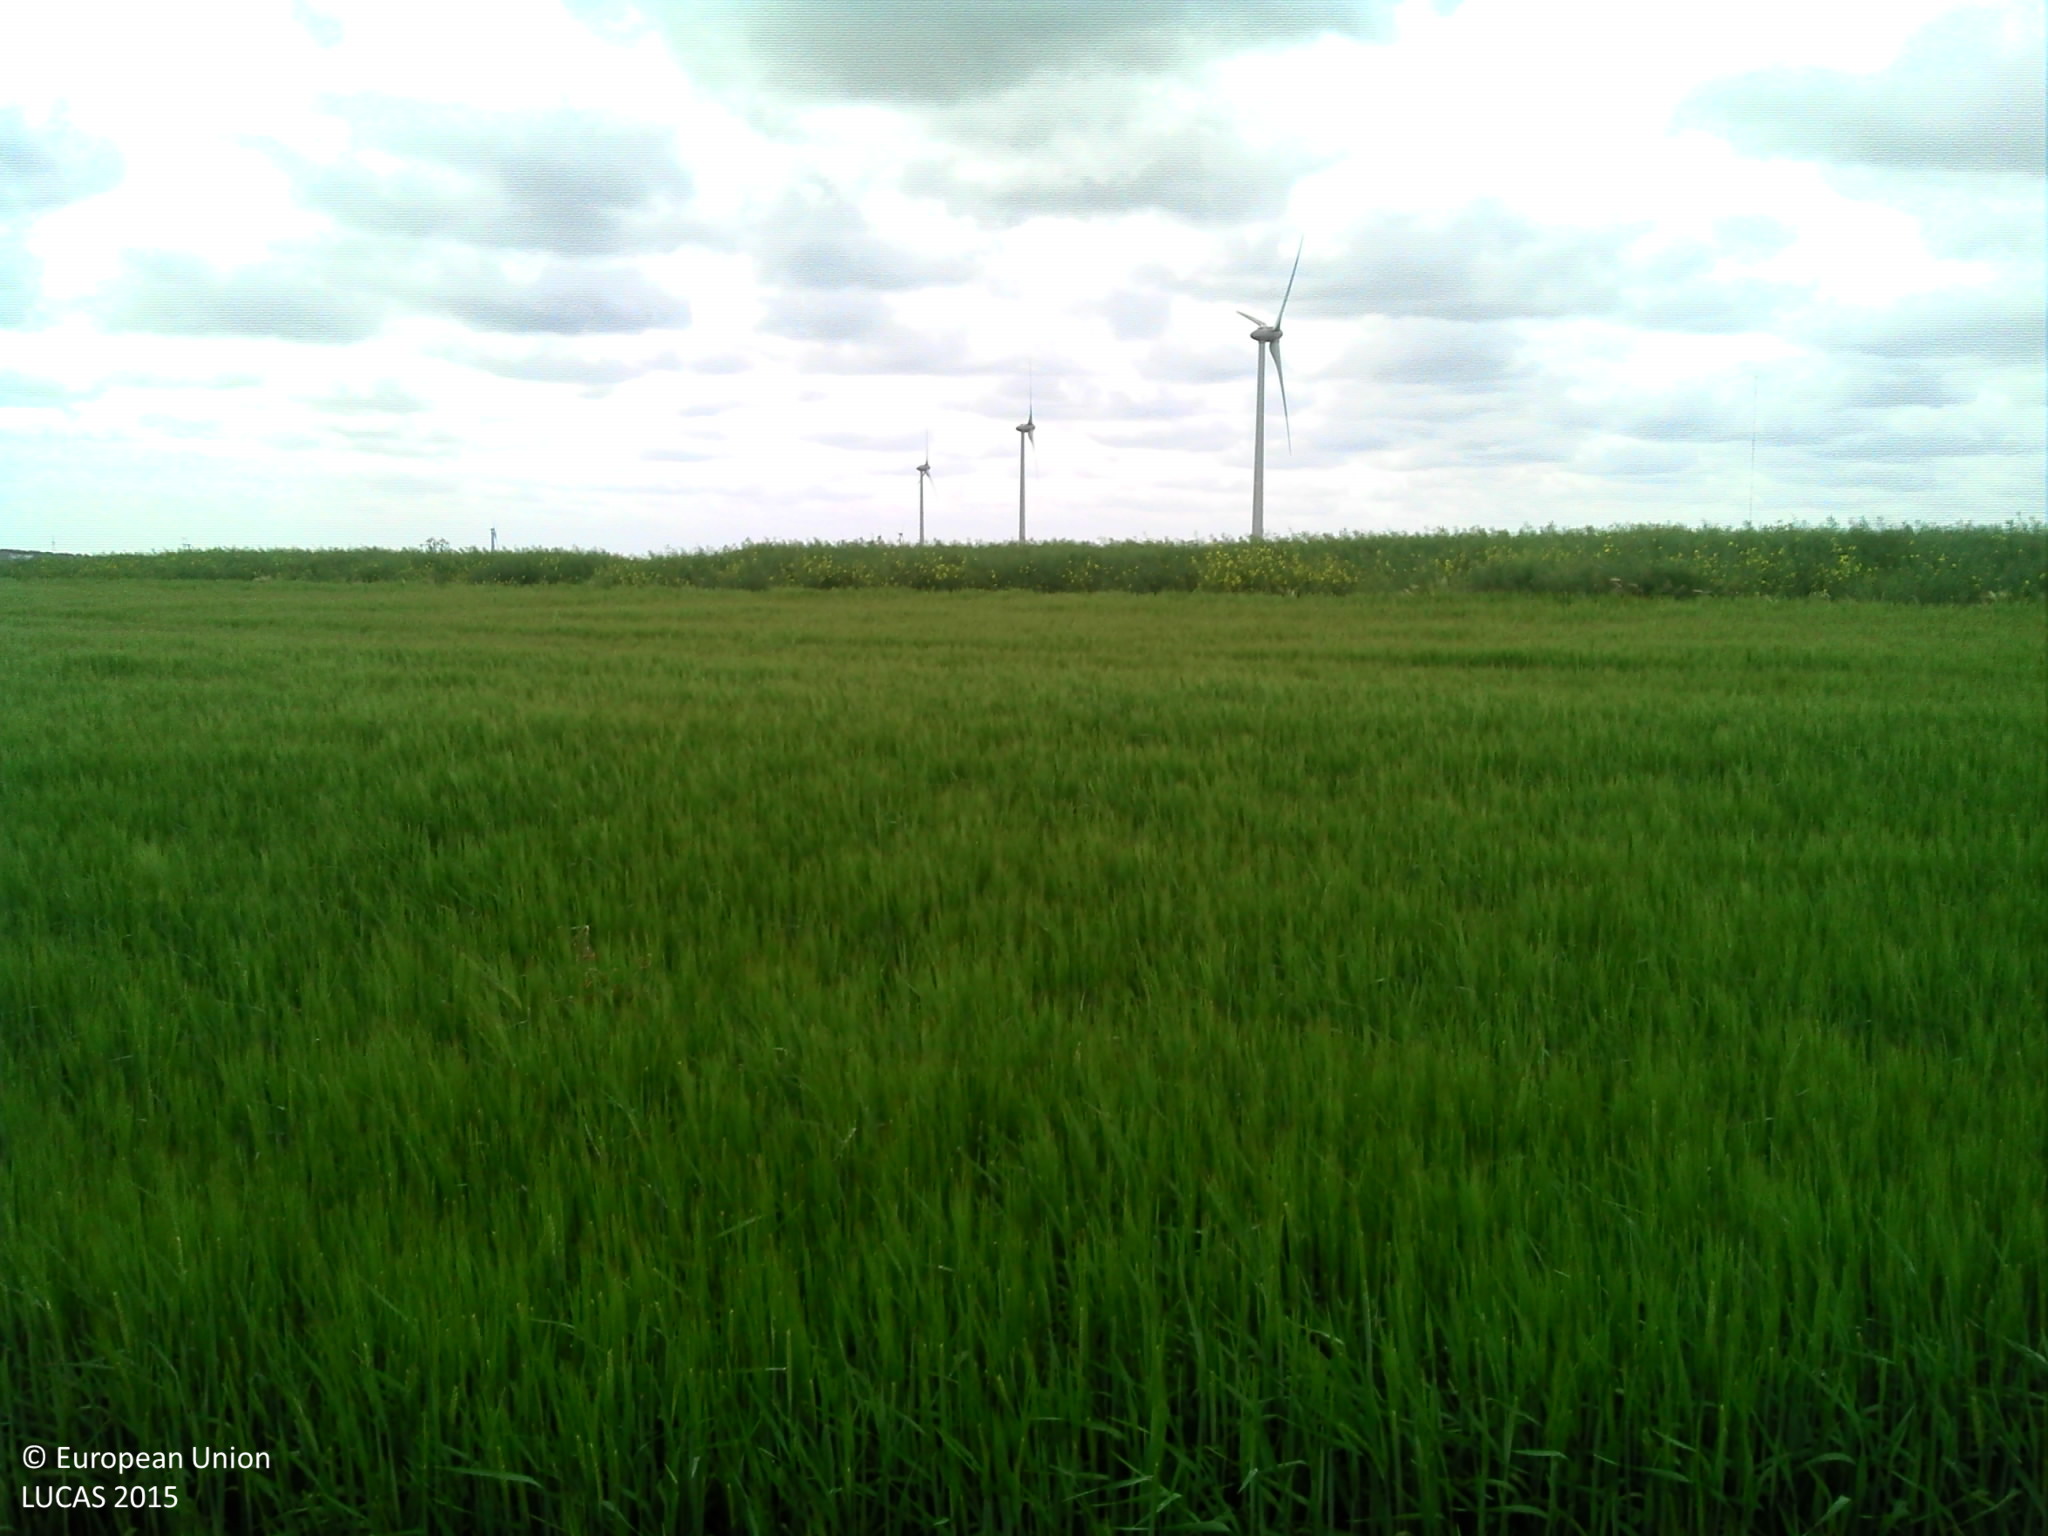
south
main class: Cropland
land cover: Barley
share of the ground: > 75 %
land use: Agriculture (excluding fallow land and kitchen gardens)
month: June
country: FR
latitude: 48.3811
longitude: 1.9527
